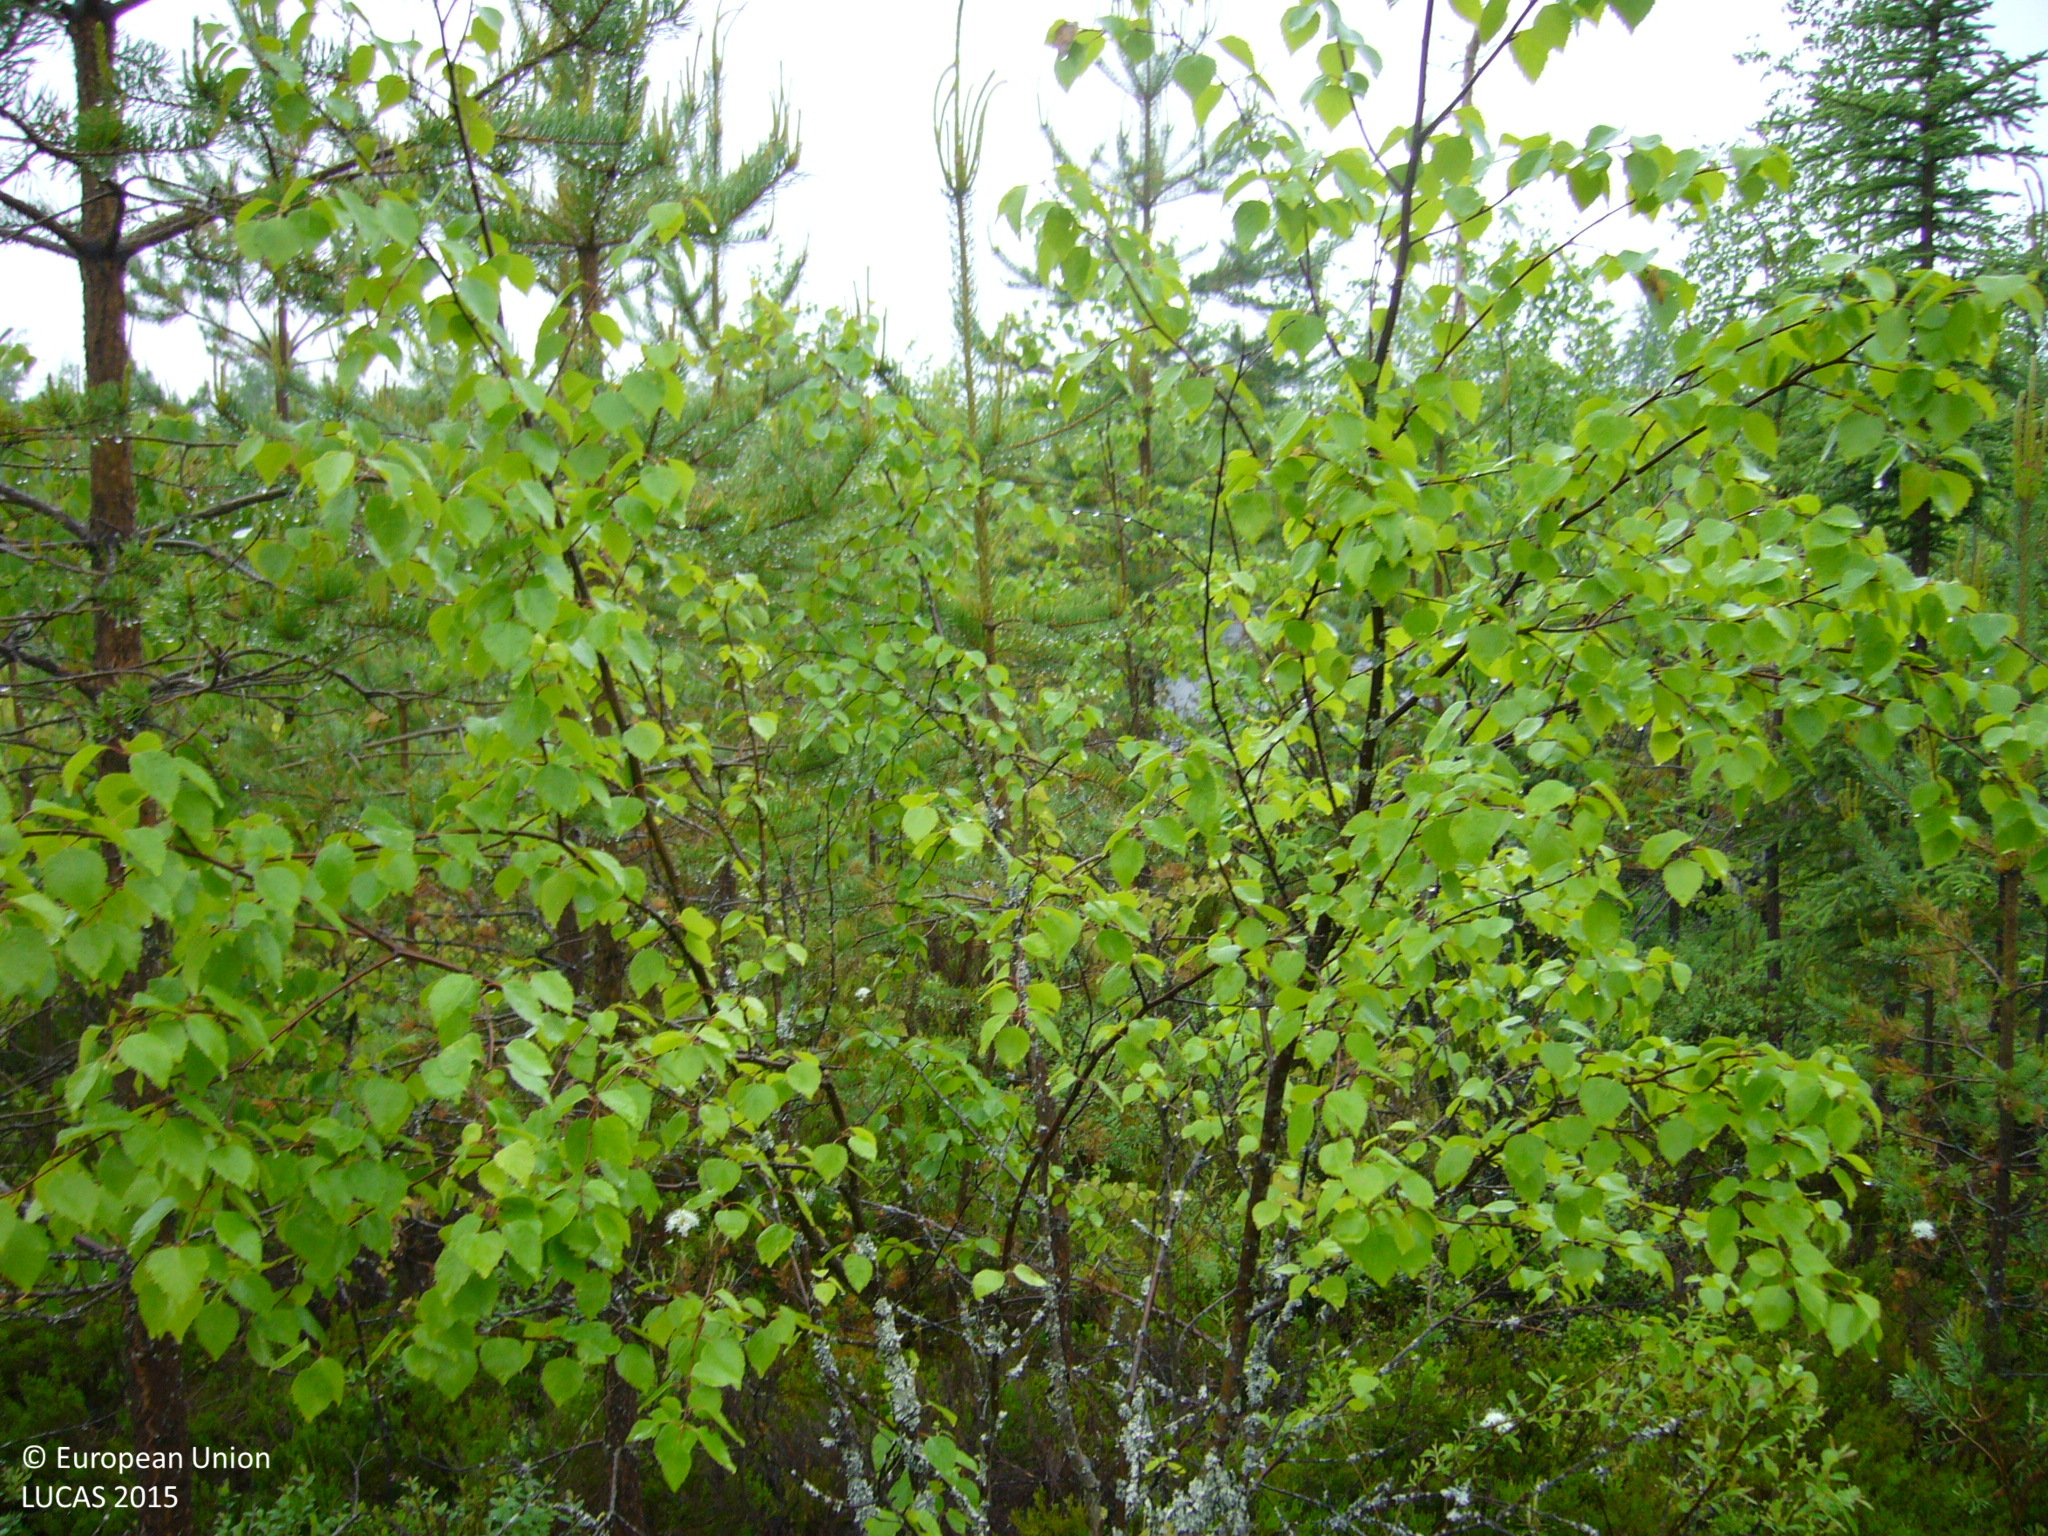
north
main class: Woodland
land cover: Pine dominated mixed woodland
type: boreal forest
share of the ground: 50 - 75 %
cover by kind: shrubs 45 %, coniferous forest trees 30 %, broadleaved forest trees 25 %
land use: Forestry
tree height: < 5 m
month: June
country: FI
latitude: 63.8112
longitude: 24.9728
